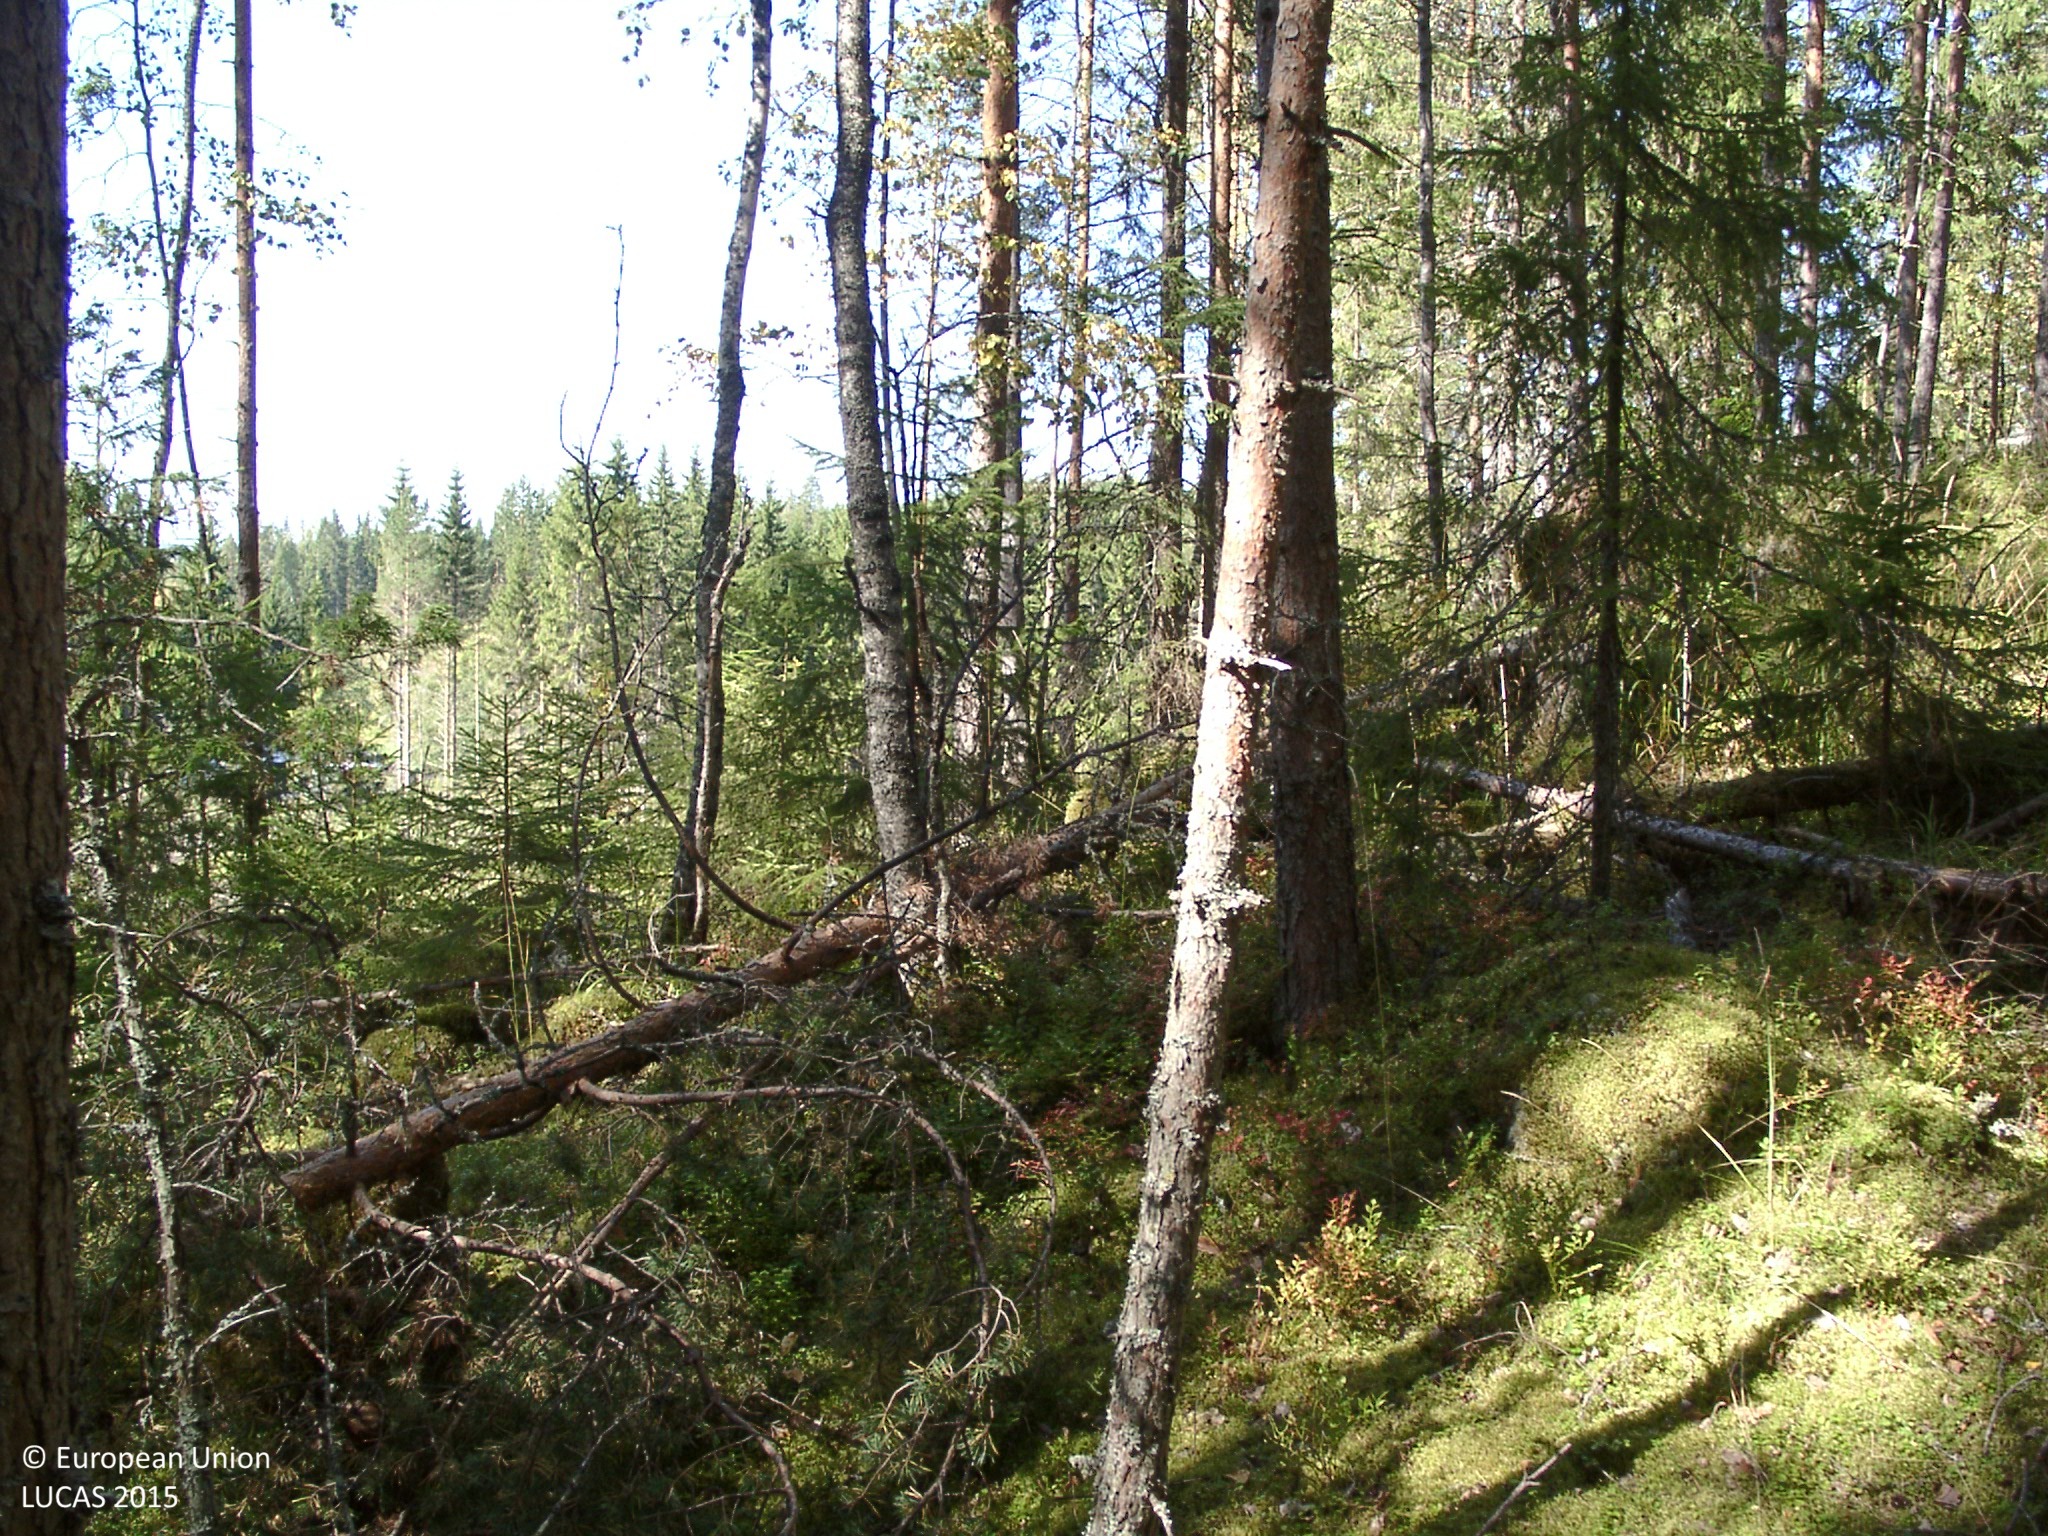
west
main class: Woodland
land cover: Other coniferous woodland
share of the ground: 50 - 75 %
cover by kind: coniferous forest trees 60 %, lichens and mosses 20 %, broadleaved forest trees 10 %, shrubs 10 %
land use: Forestry
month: August
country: FI
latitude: 61.7377
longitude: 25.2389
